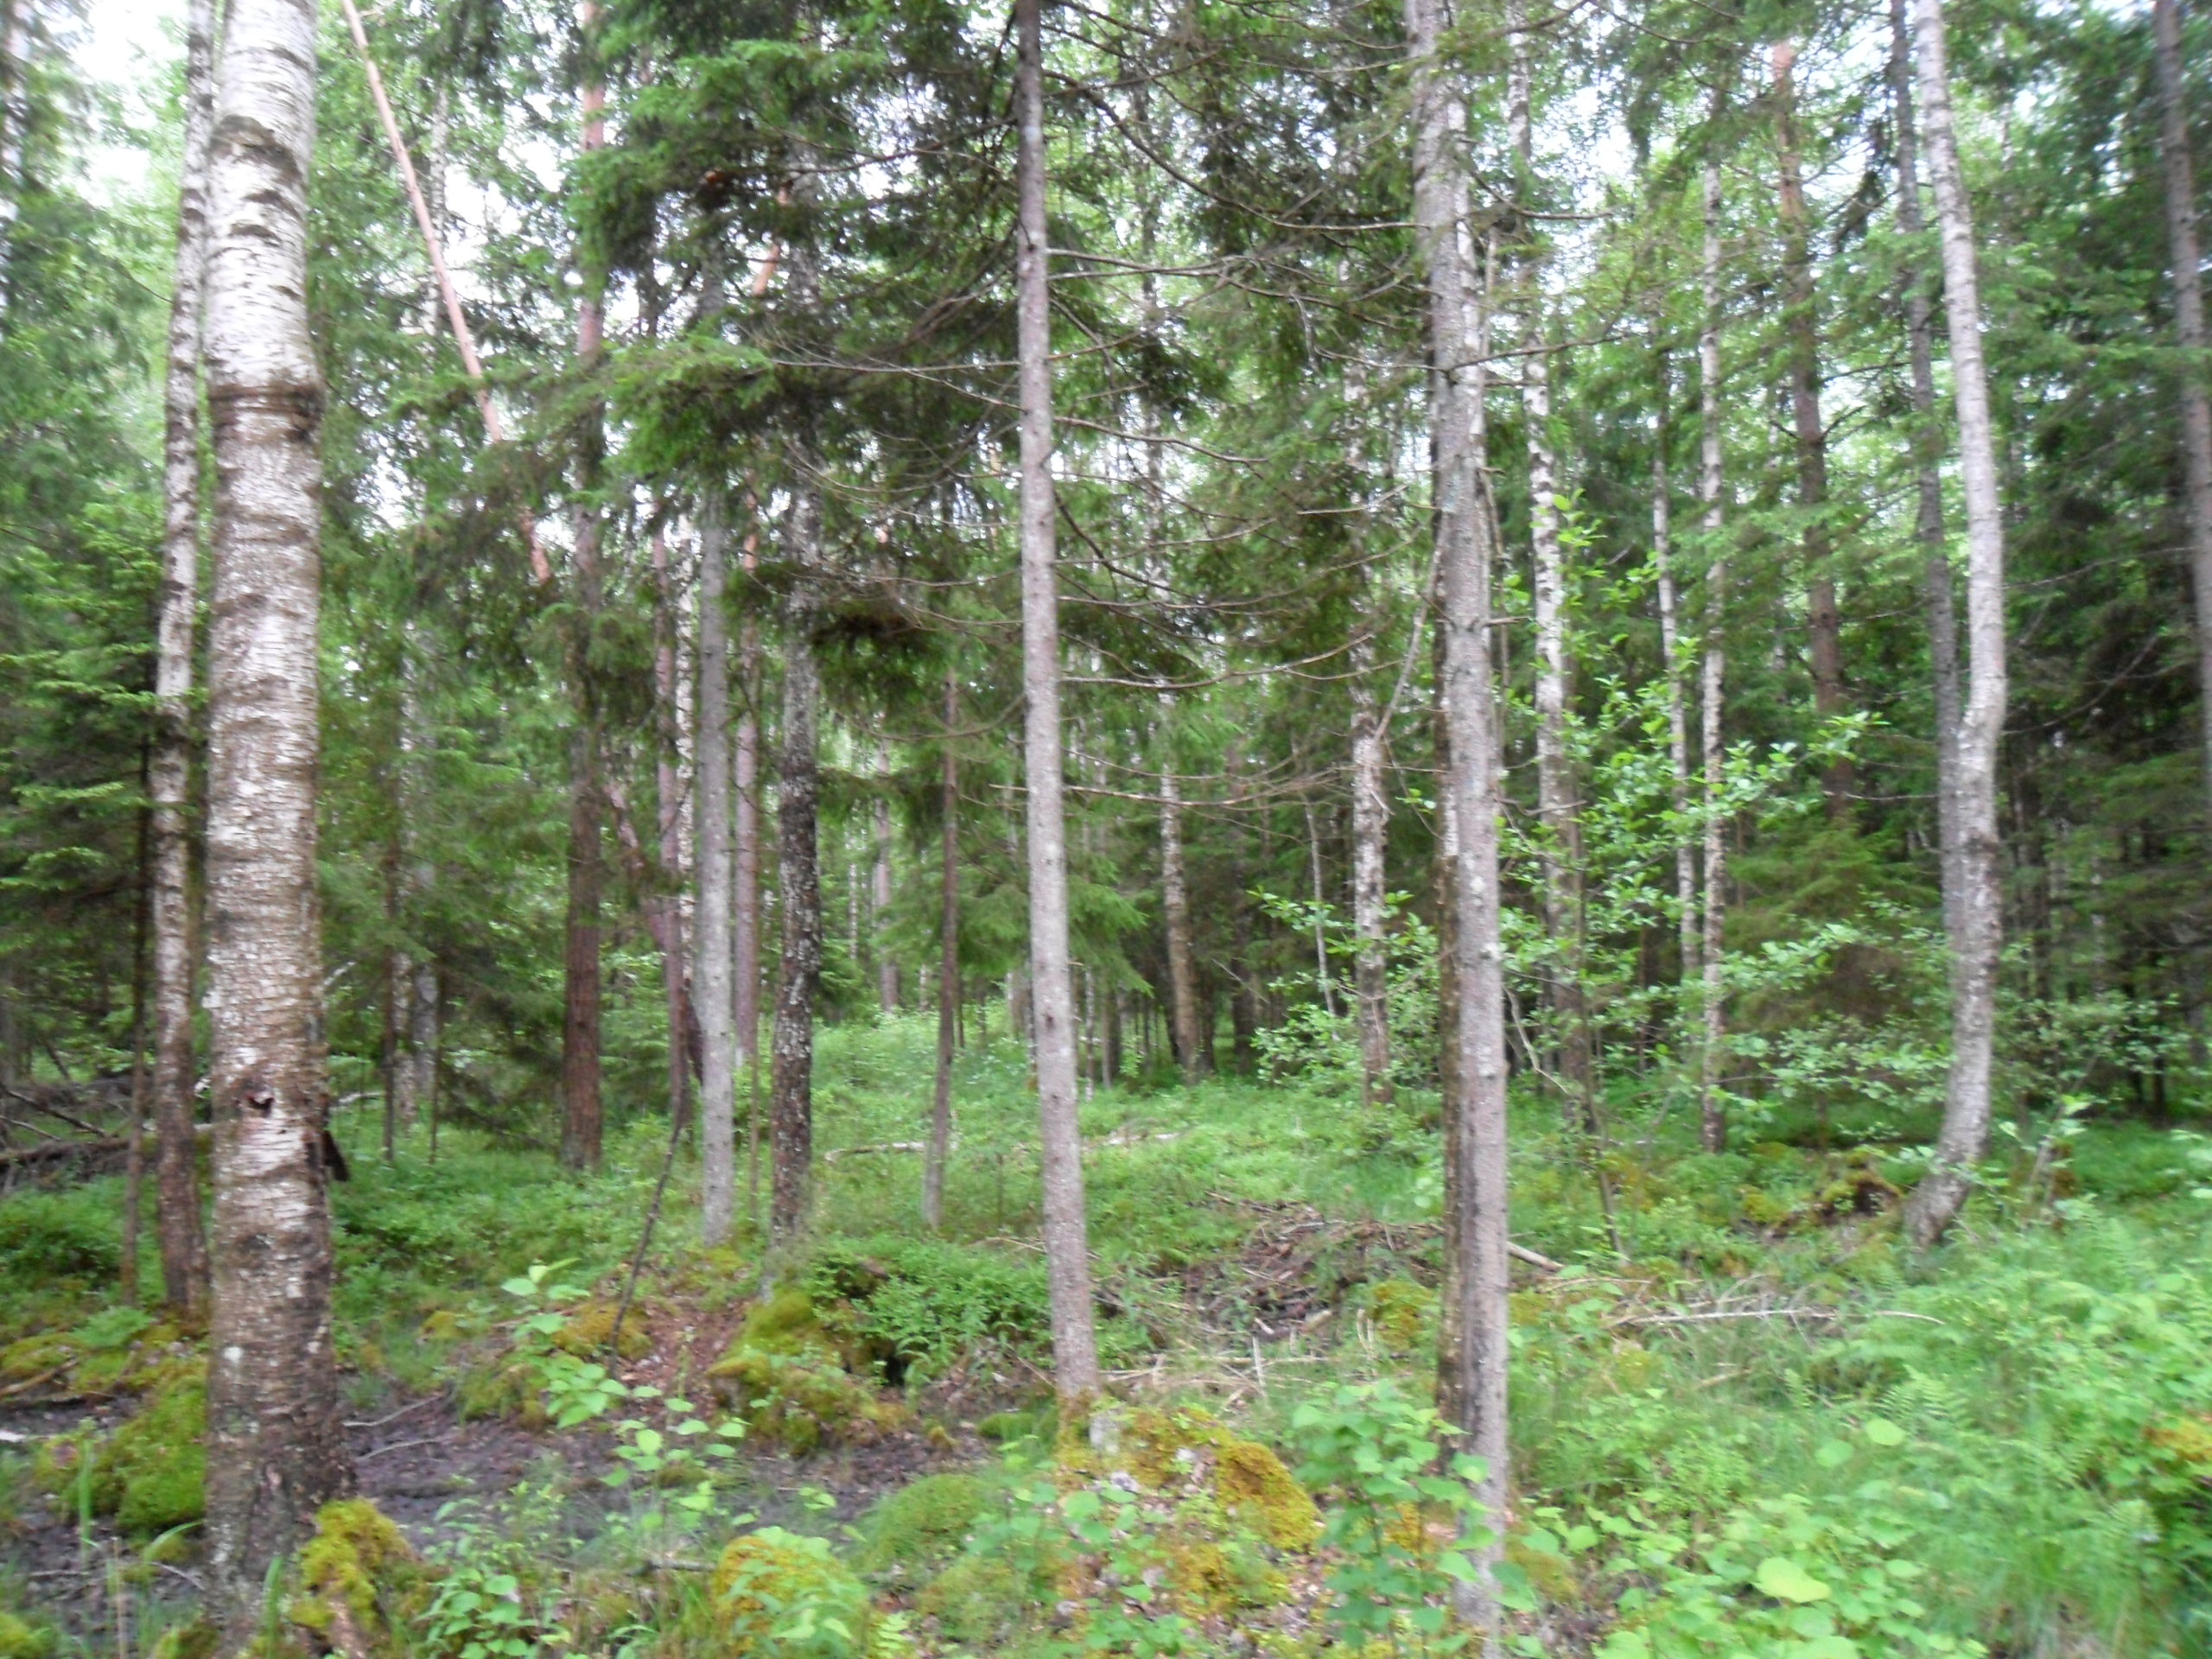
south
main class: Woodland
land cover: Other mixed woodland
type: hemiboreal forest and nemoral coniferous forest and mixed broadleaved-coniferous forest
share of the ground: 50 - 75 %
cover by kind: coniferous forest trees 40 %, broadleaved forest trees 30 %, herbaceous plants 20 %, shrubs 10 %
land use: Forestry
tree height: > 5 m
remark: Temporary flooded
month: June
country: LV
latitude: 57.4875
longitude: 22.1074
